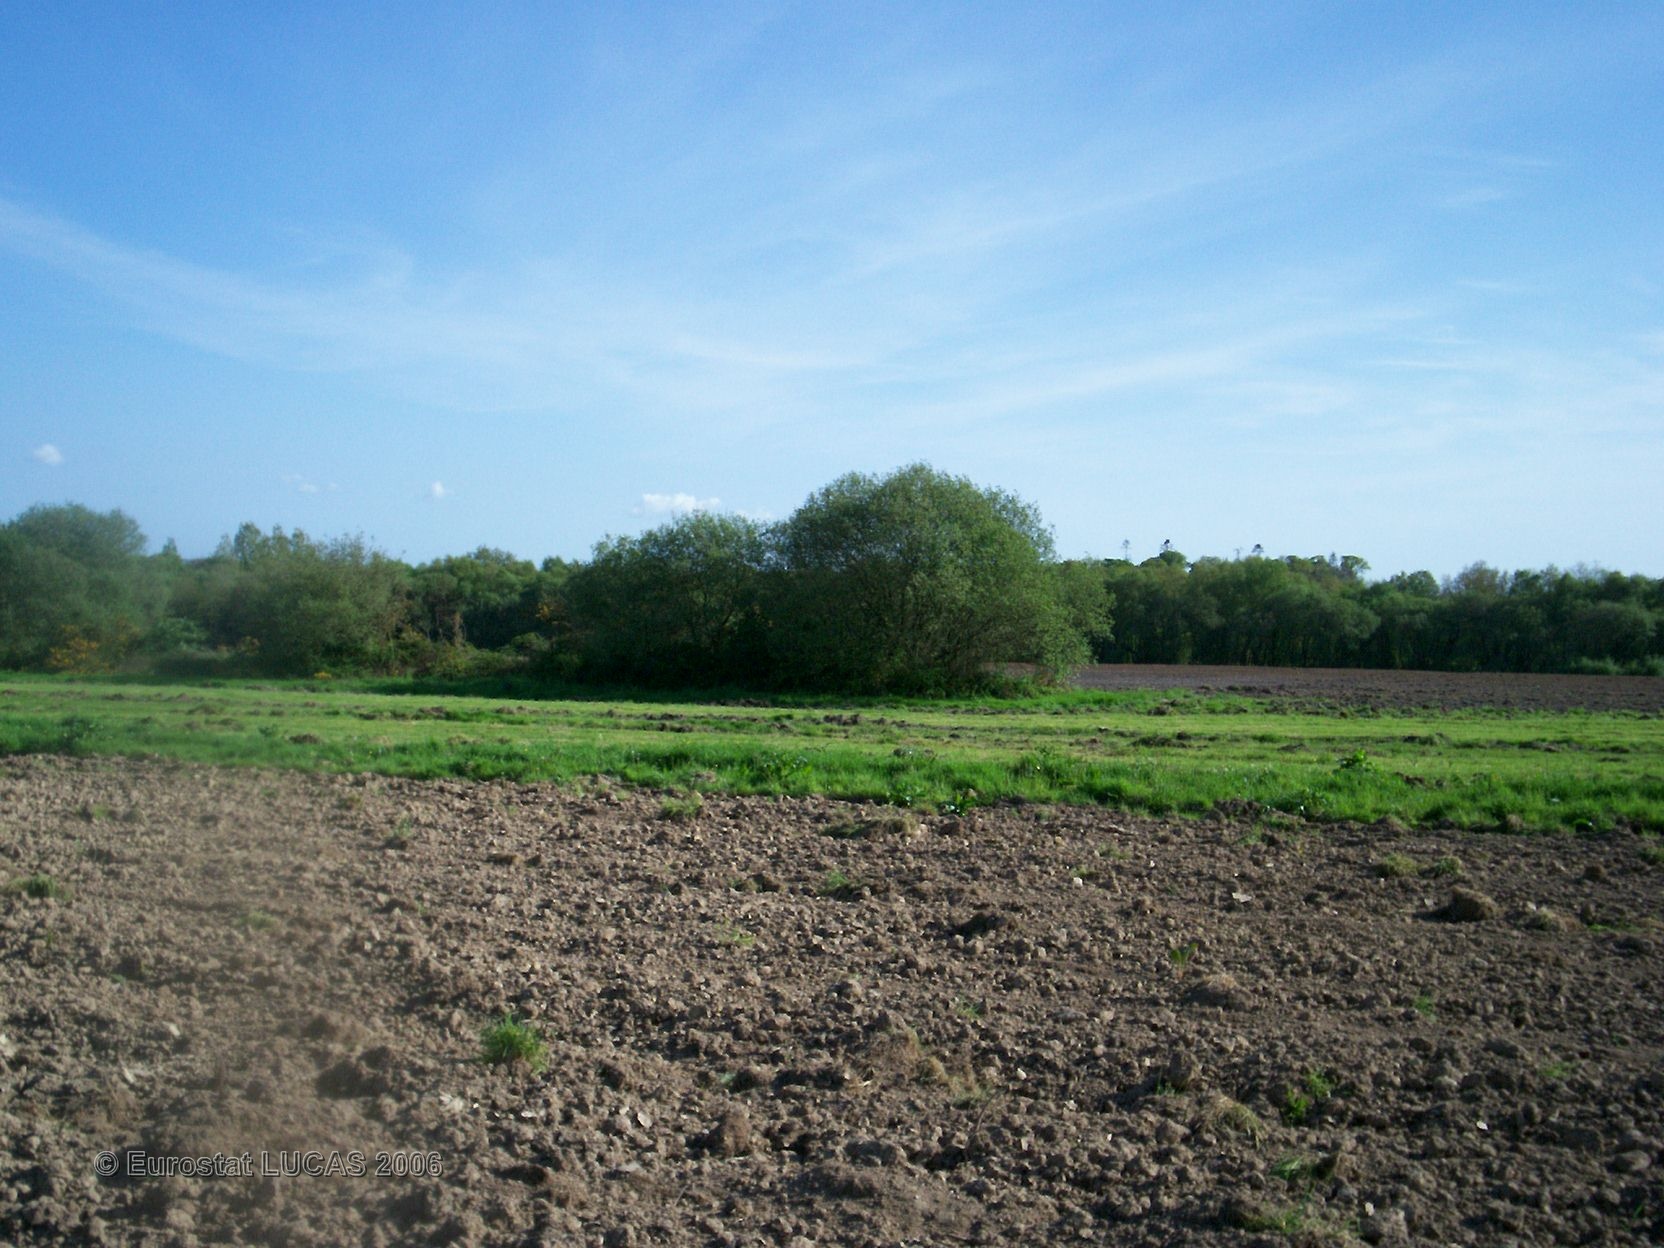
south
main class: Cropland
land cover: Maize
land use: Agriculture (excluding fallow land and kitchen gardens)
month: May
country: FR
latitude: 48.0059
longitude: -2.9210
